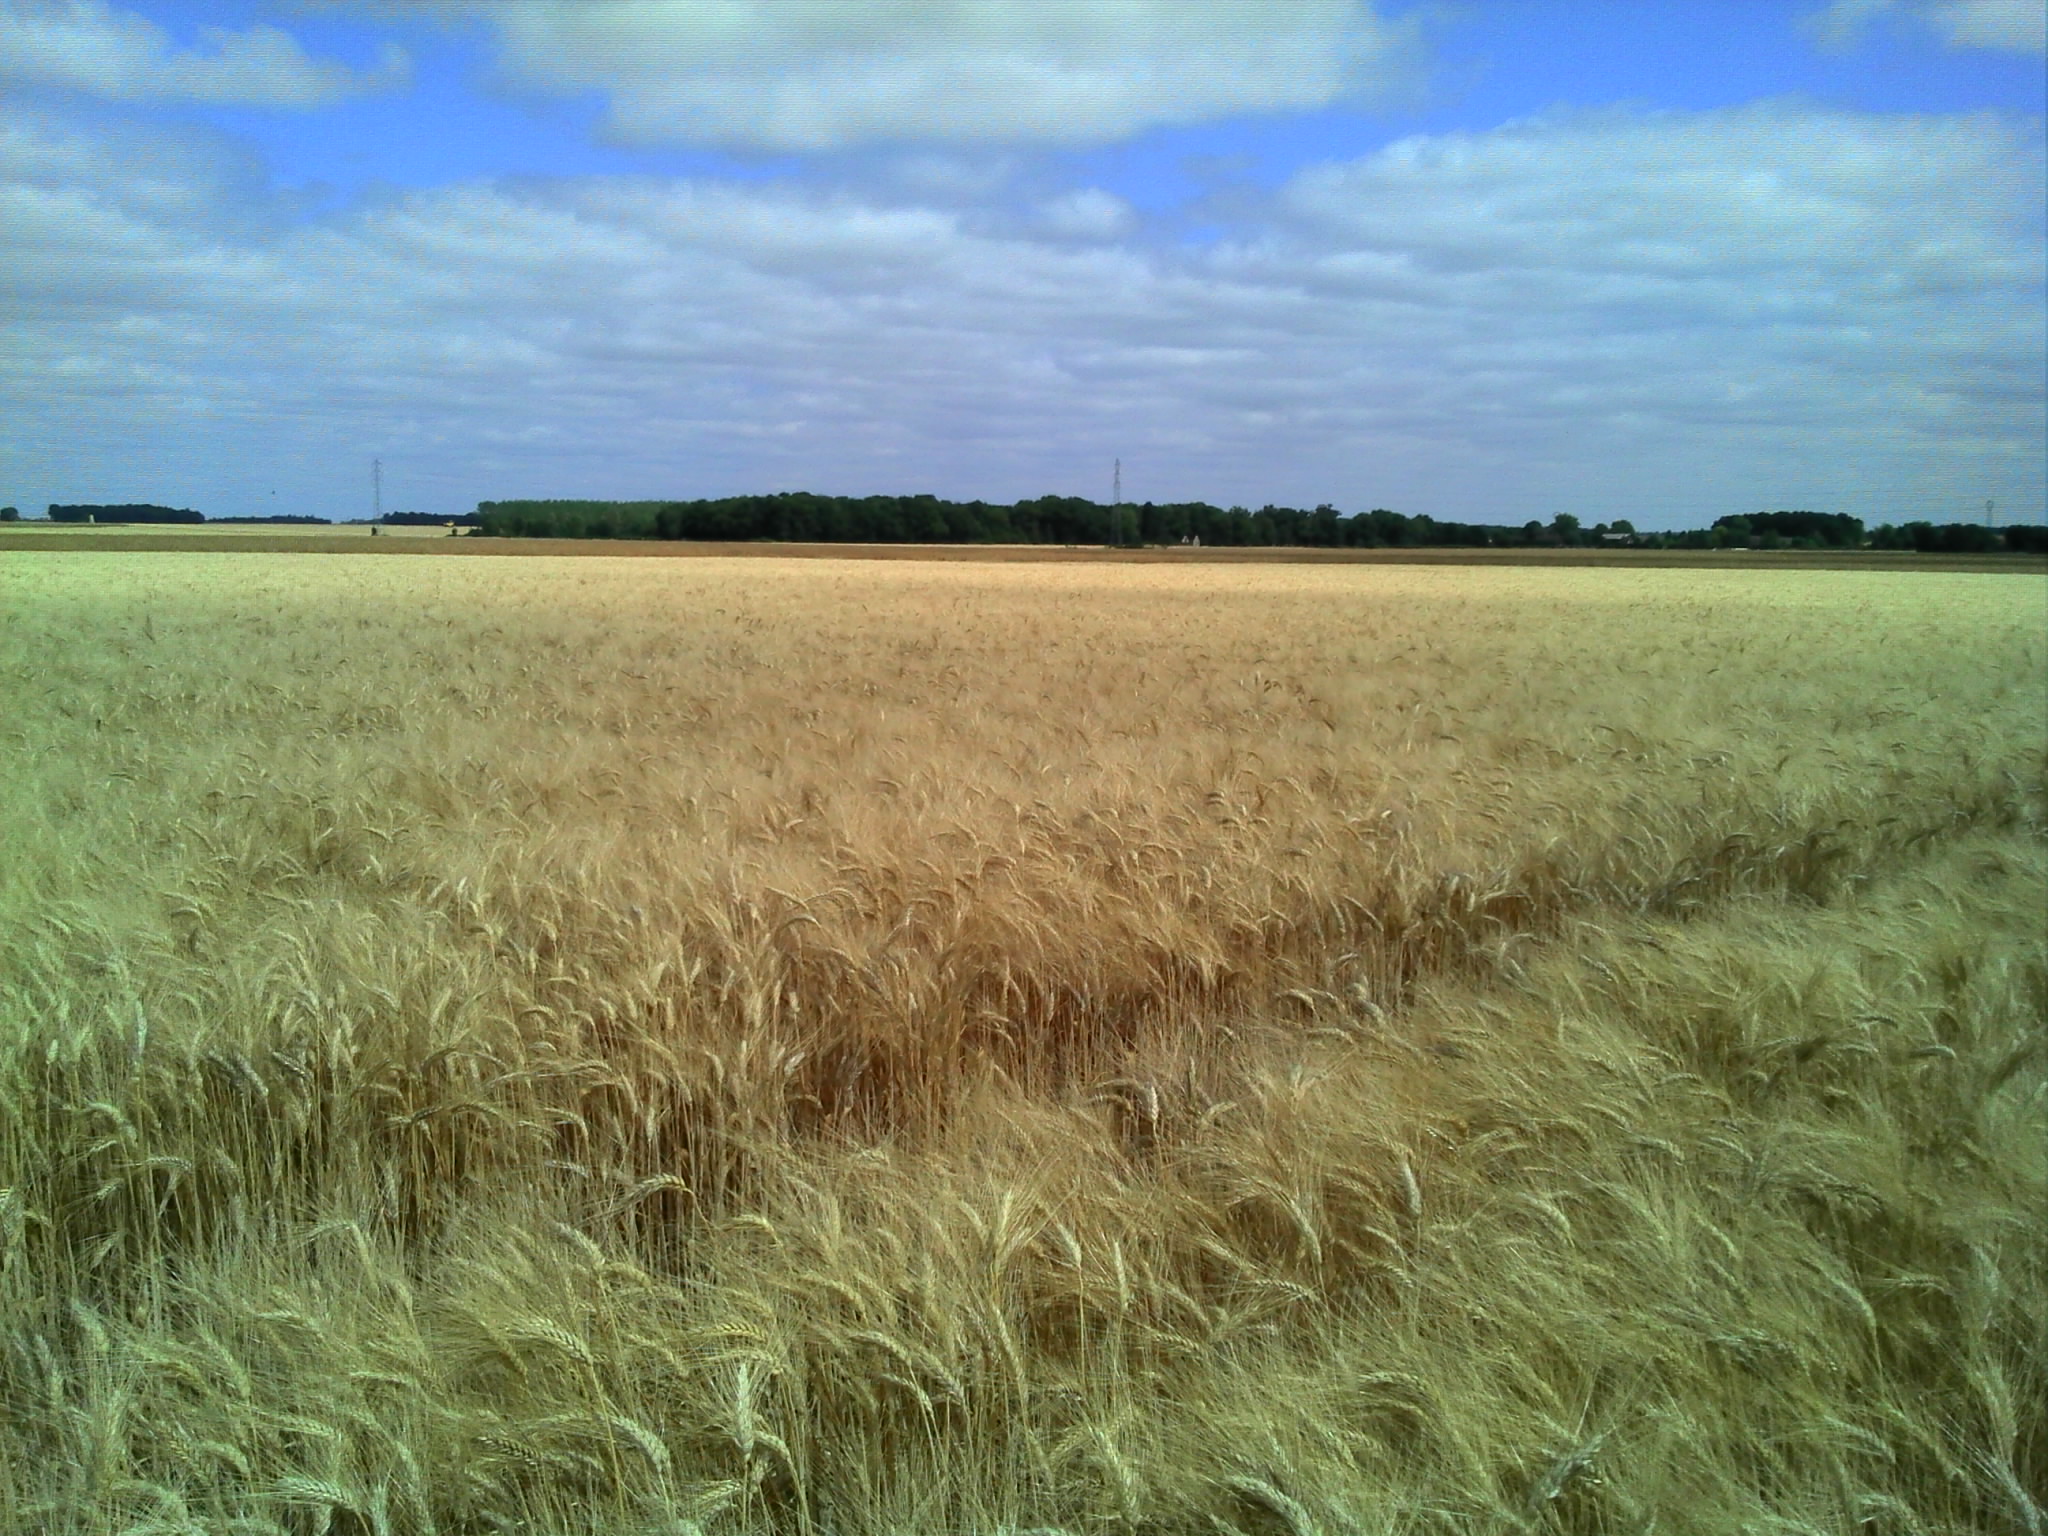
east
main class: Cropland
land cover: Barley
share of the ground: > 75 %
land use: Agriculture (excluding fallow land and kitchen gardens)
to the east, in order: Barley; Rape and turnip rape; Grass margins; Tracks; Grass margins; Rape and turnip rape
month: July
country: FR
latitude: 48.7923
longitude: 0.9535
